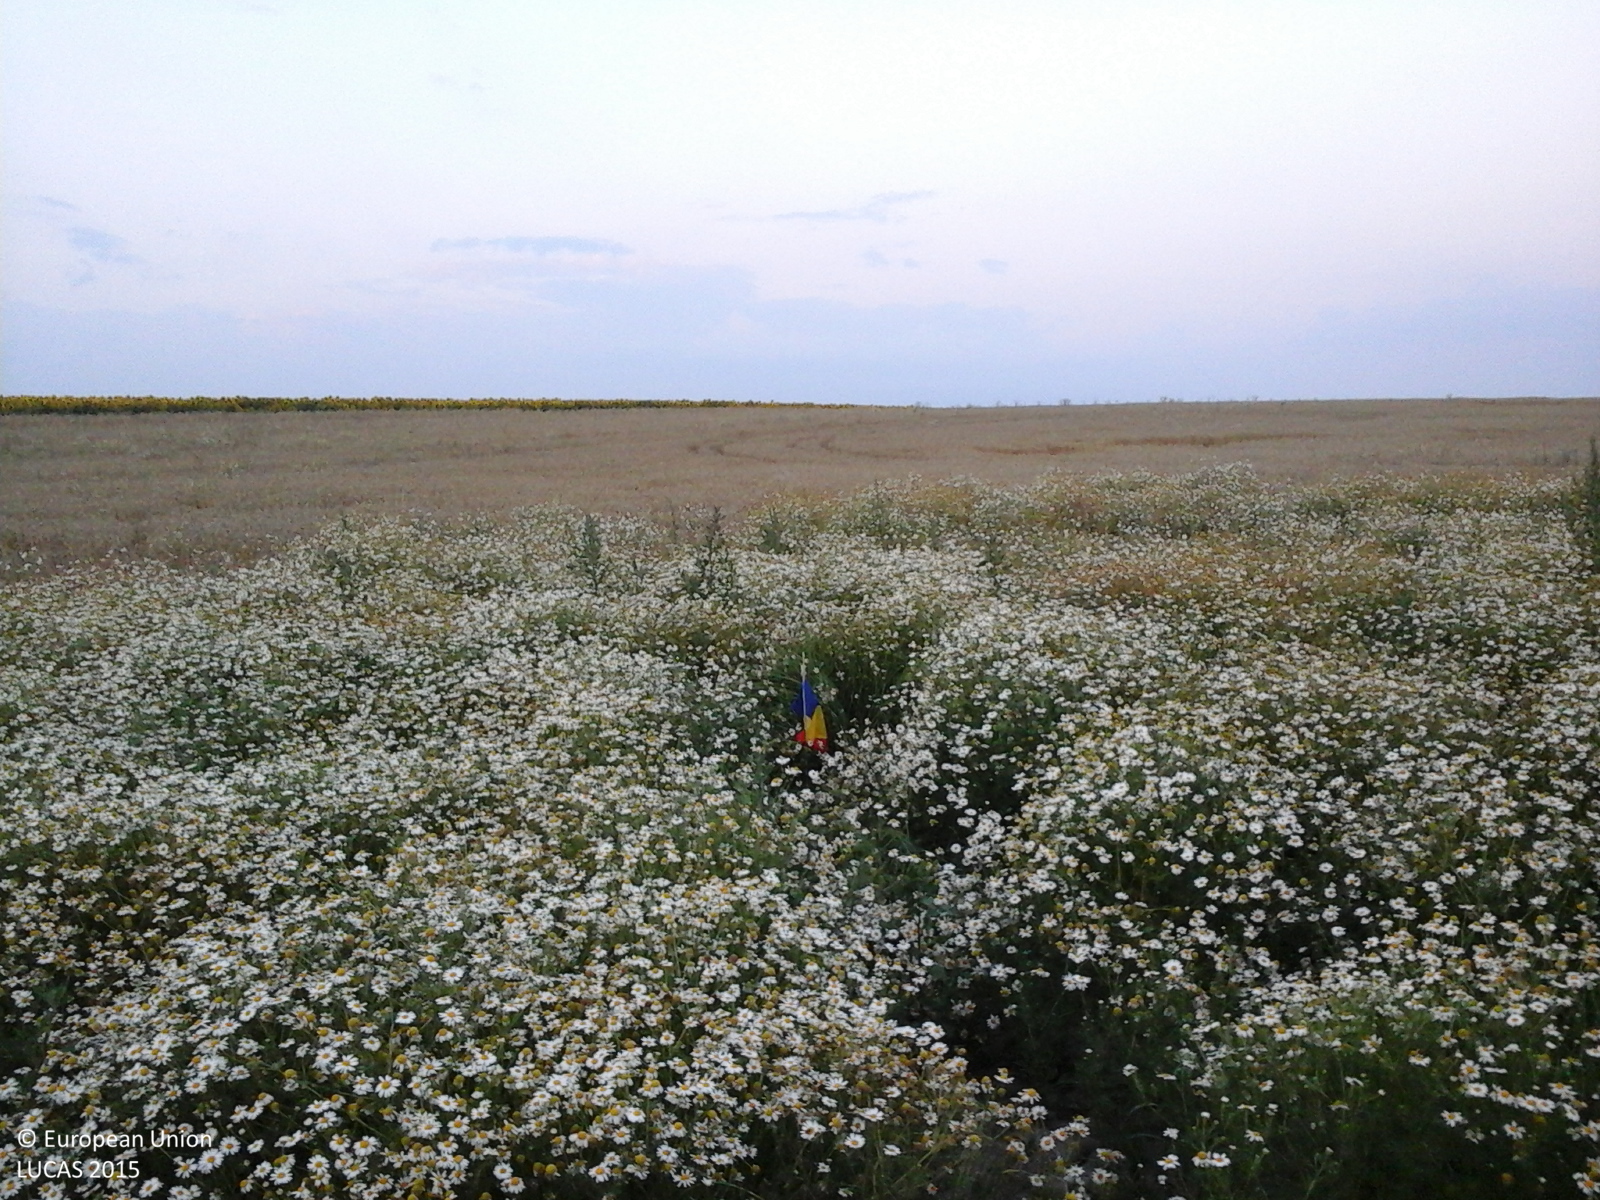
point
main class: Cropland
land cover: Other non-permanent industrial crops
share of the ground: > 75 %
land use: Agriculture (excluding fallow land and kitchen gardens)
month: July
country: RO
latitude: 43.7799
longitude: 25.2756
